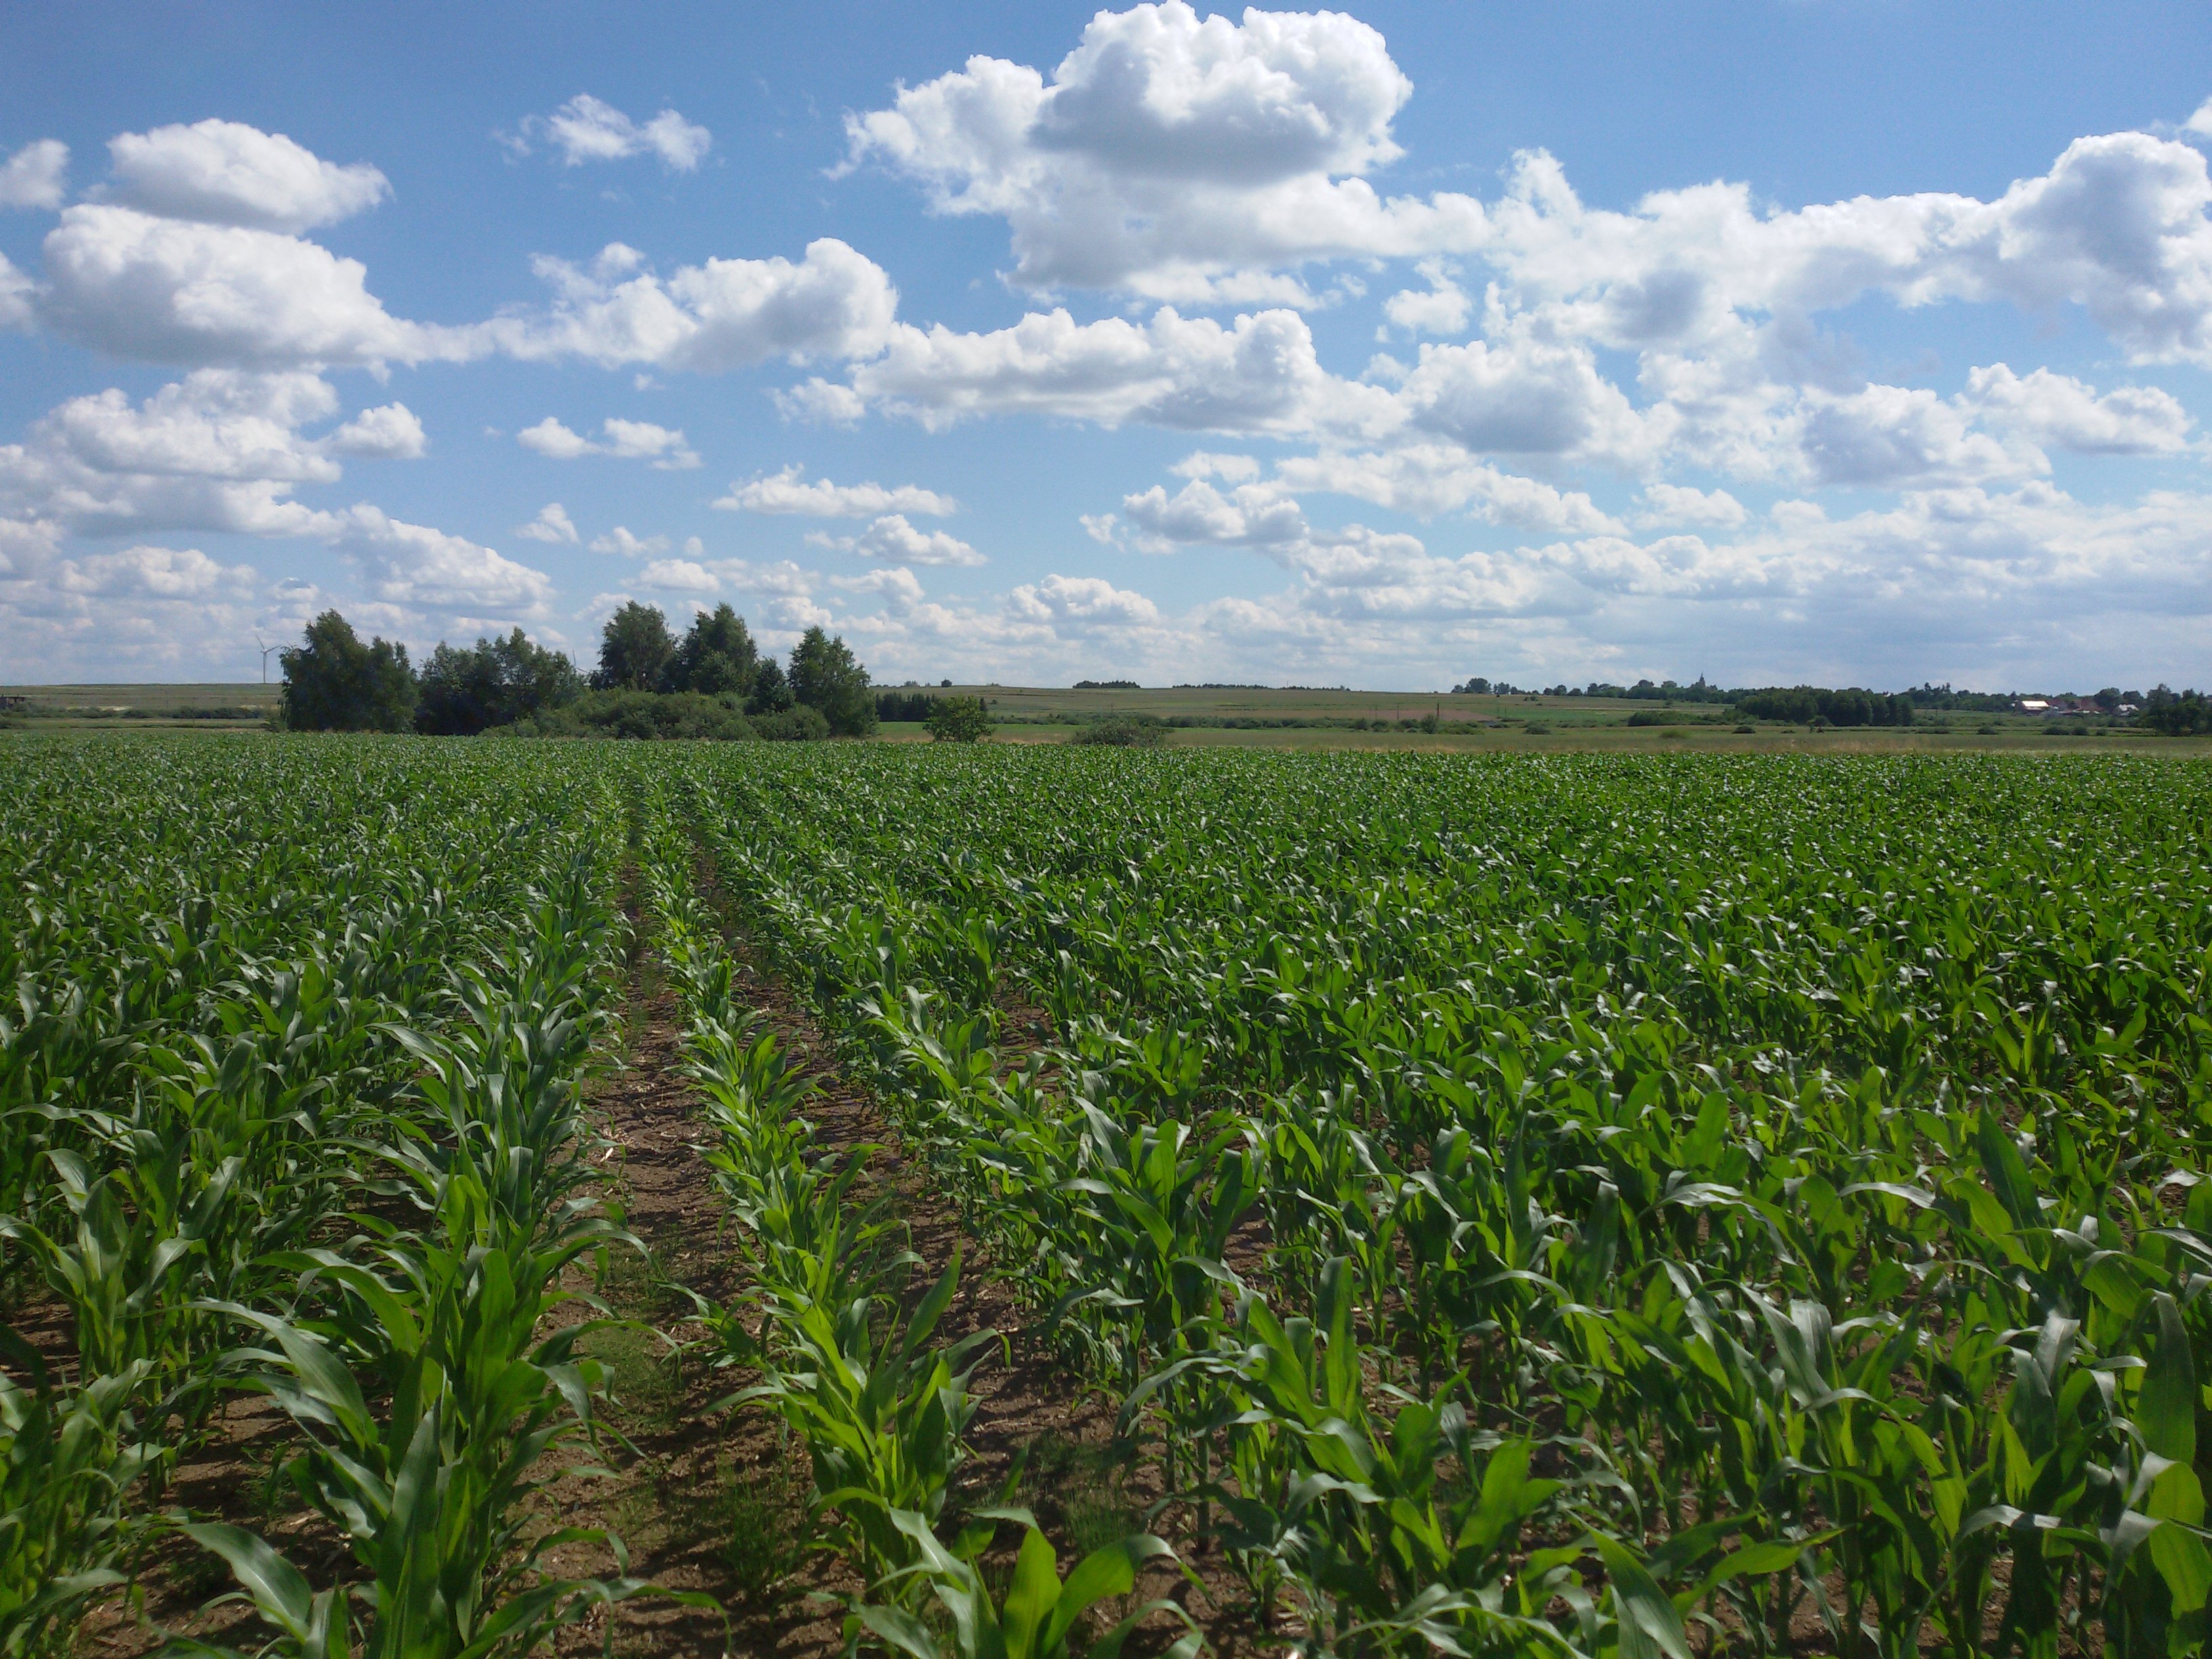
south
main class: Cropland
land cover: Maize
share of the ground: 50 - 75 %
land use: Agriculture (excluding fallow land and kitchen gardens)
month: June
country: PL
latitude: 50.0920
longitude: 22.3495
